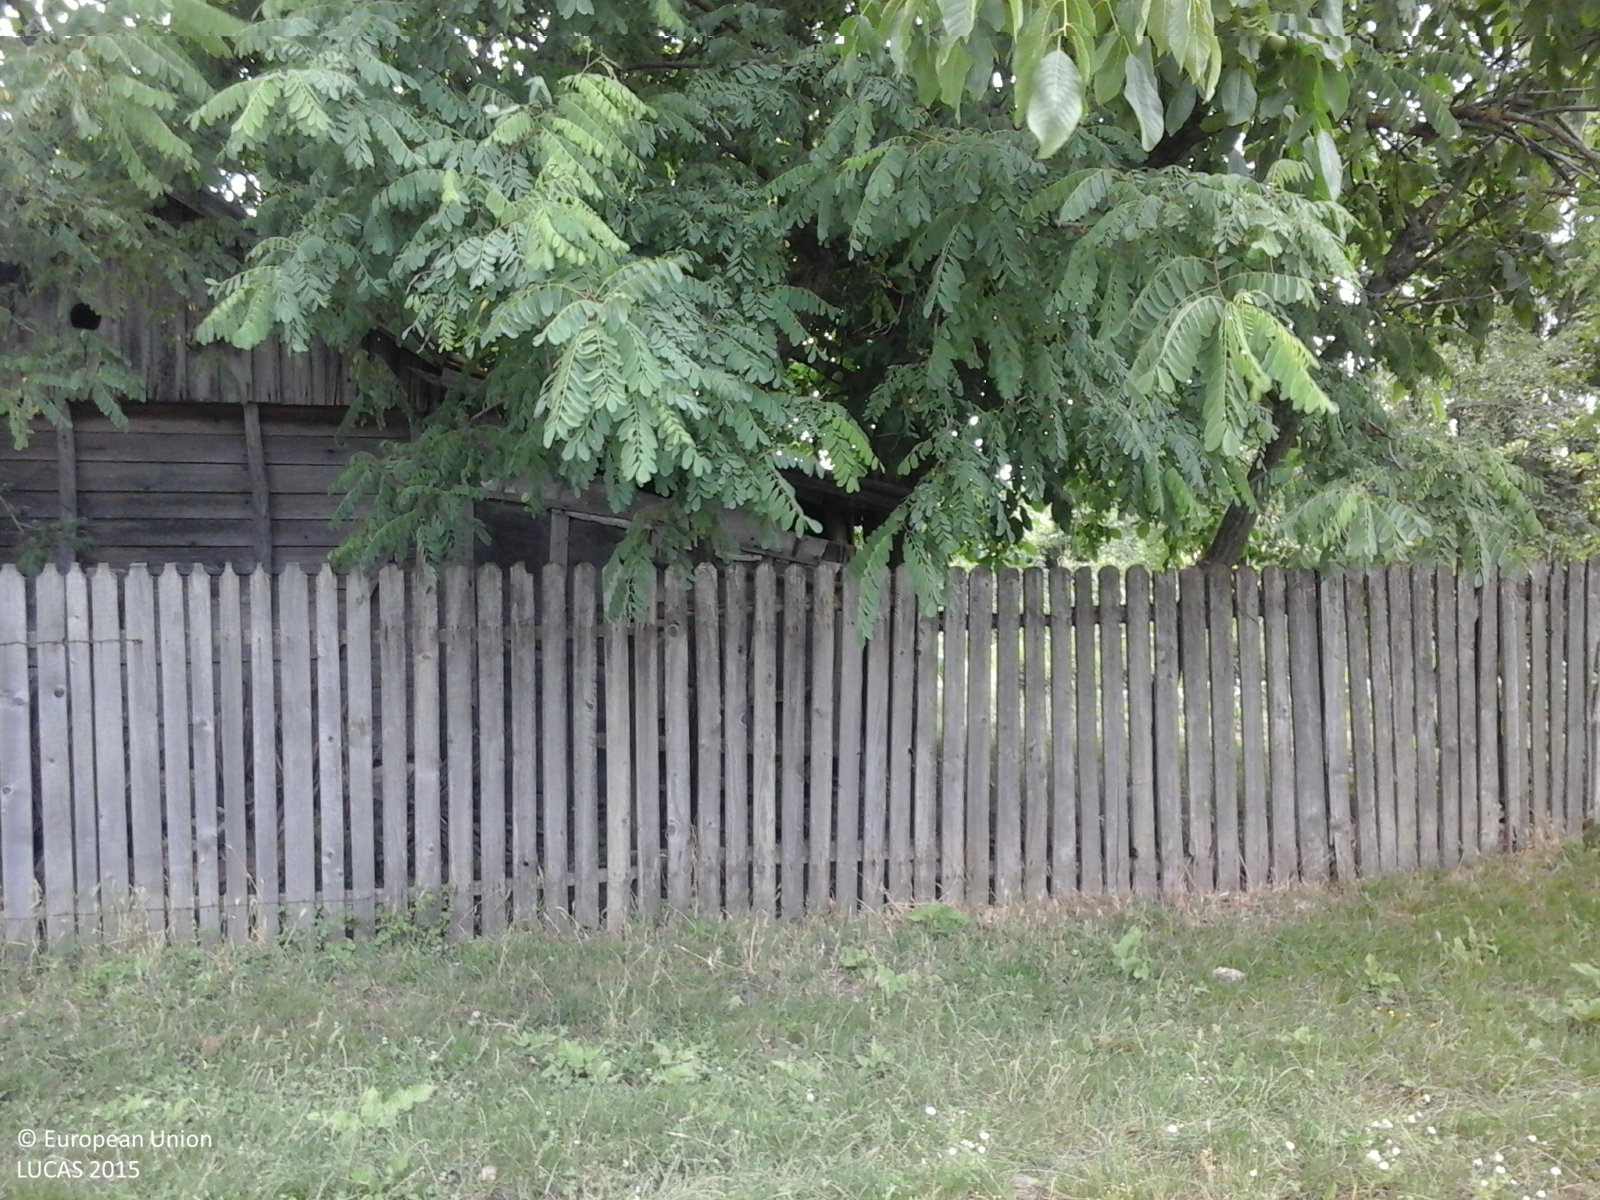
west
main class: Cropland
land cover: Other fresh vegetables
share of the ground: > 75 %
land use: Kitchen garden
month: July
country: RO
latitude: 44.1060
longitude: 24.8027
